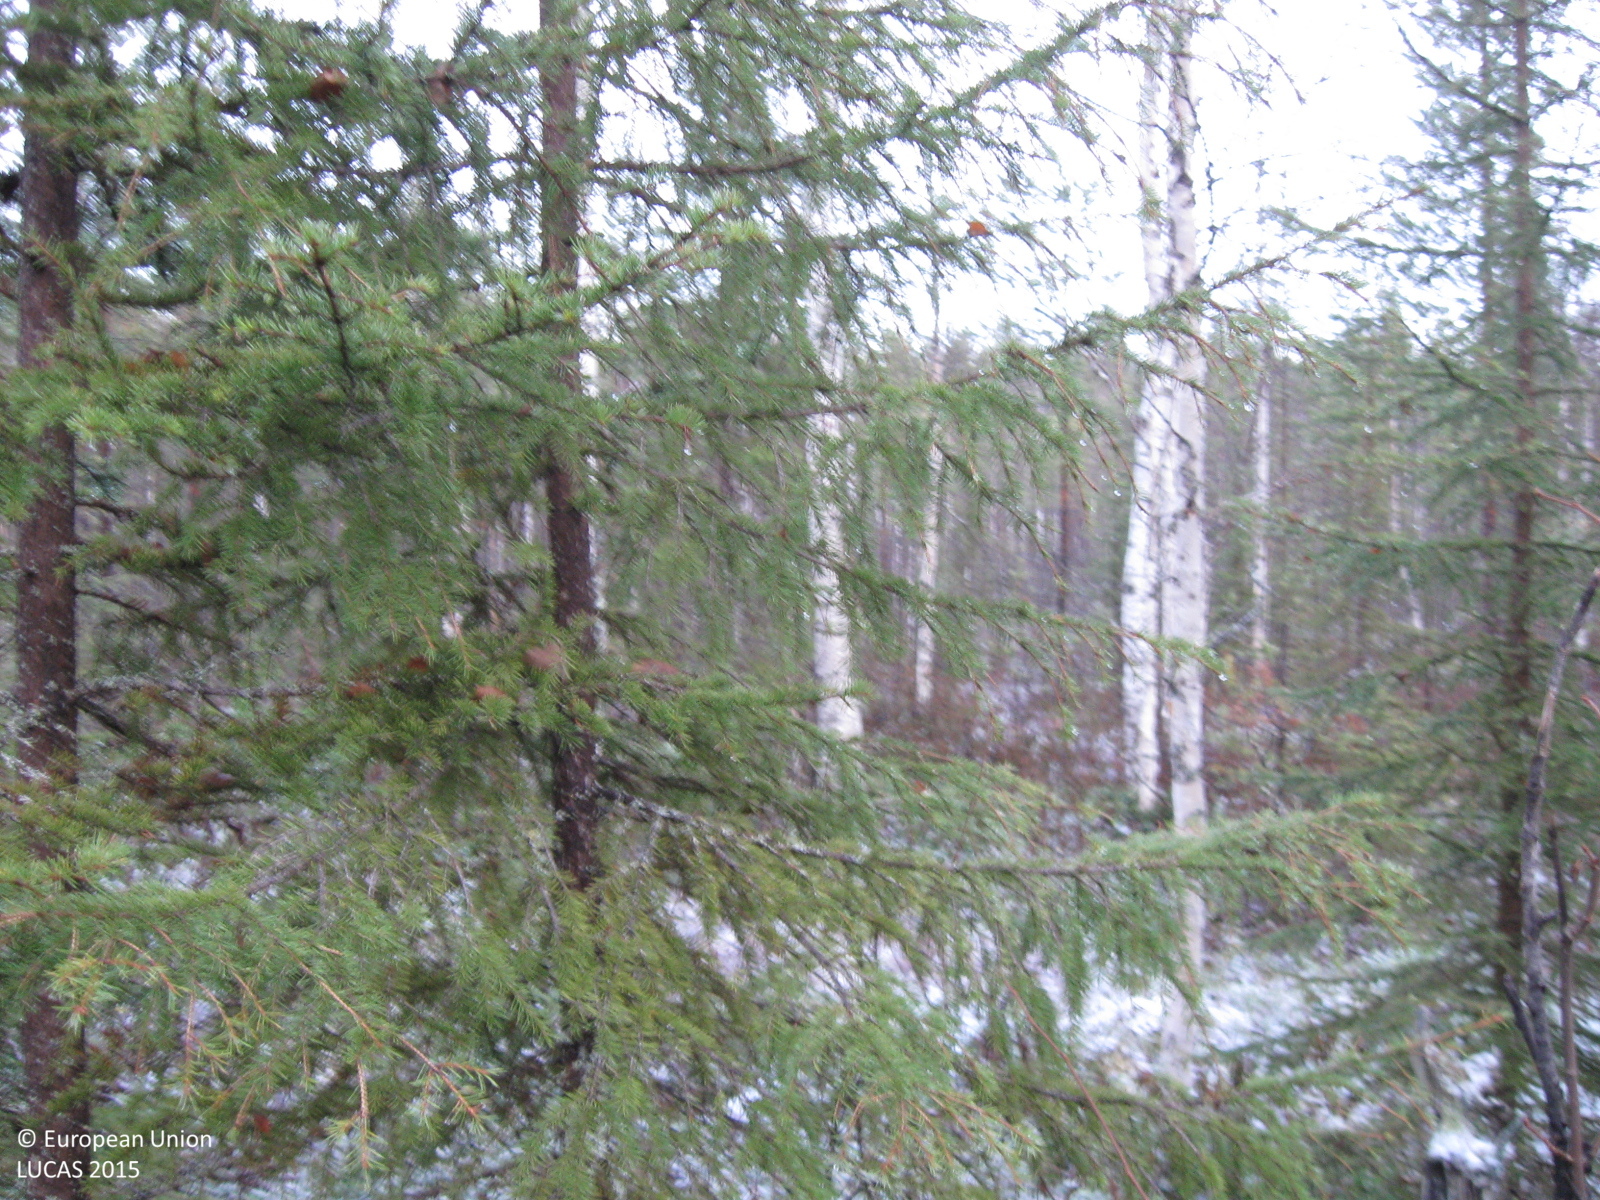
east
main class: Woodland
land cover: Spruce dominated mixed woodland
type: boreal forest
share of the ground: > 75 %
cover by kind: broadleaved forest trees 55 %, coniferous forest trees 20 %, shrubs 10 %, herbaceous plants 10 %, lichens and mosses 5 %
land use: Forestry
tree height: > 5 m
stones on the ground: < 10 %
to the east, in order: Spruce dominated mixed woodland; Other mixed woodland; Pine dominated mixed woodland; Tracks; Pine dominated coniferous woodland
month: October
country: SE
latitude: 66.2203
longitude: 20.8293
